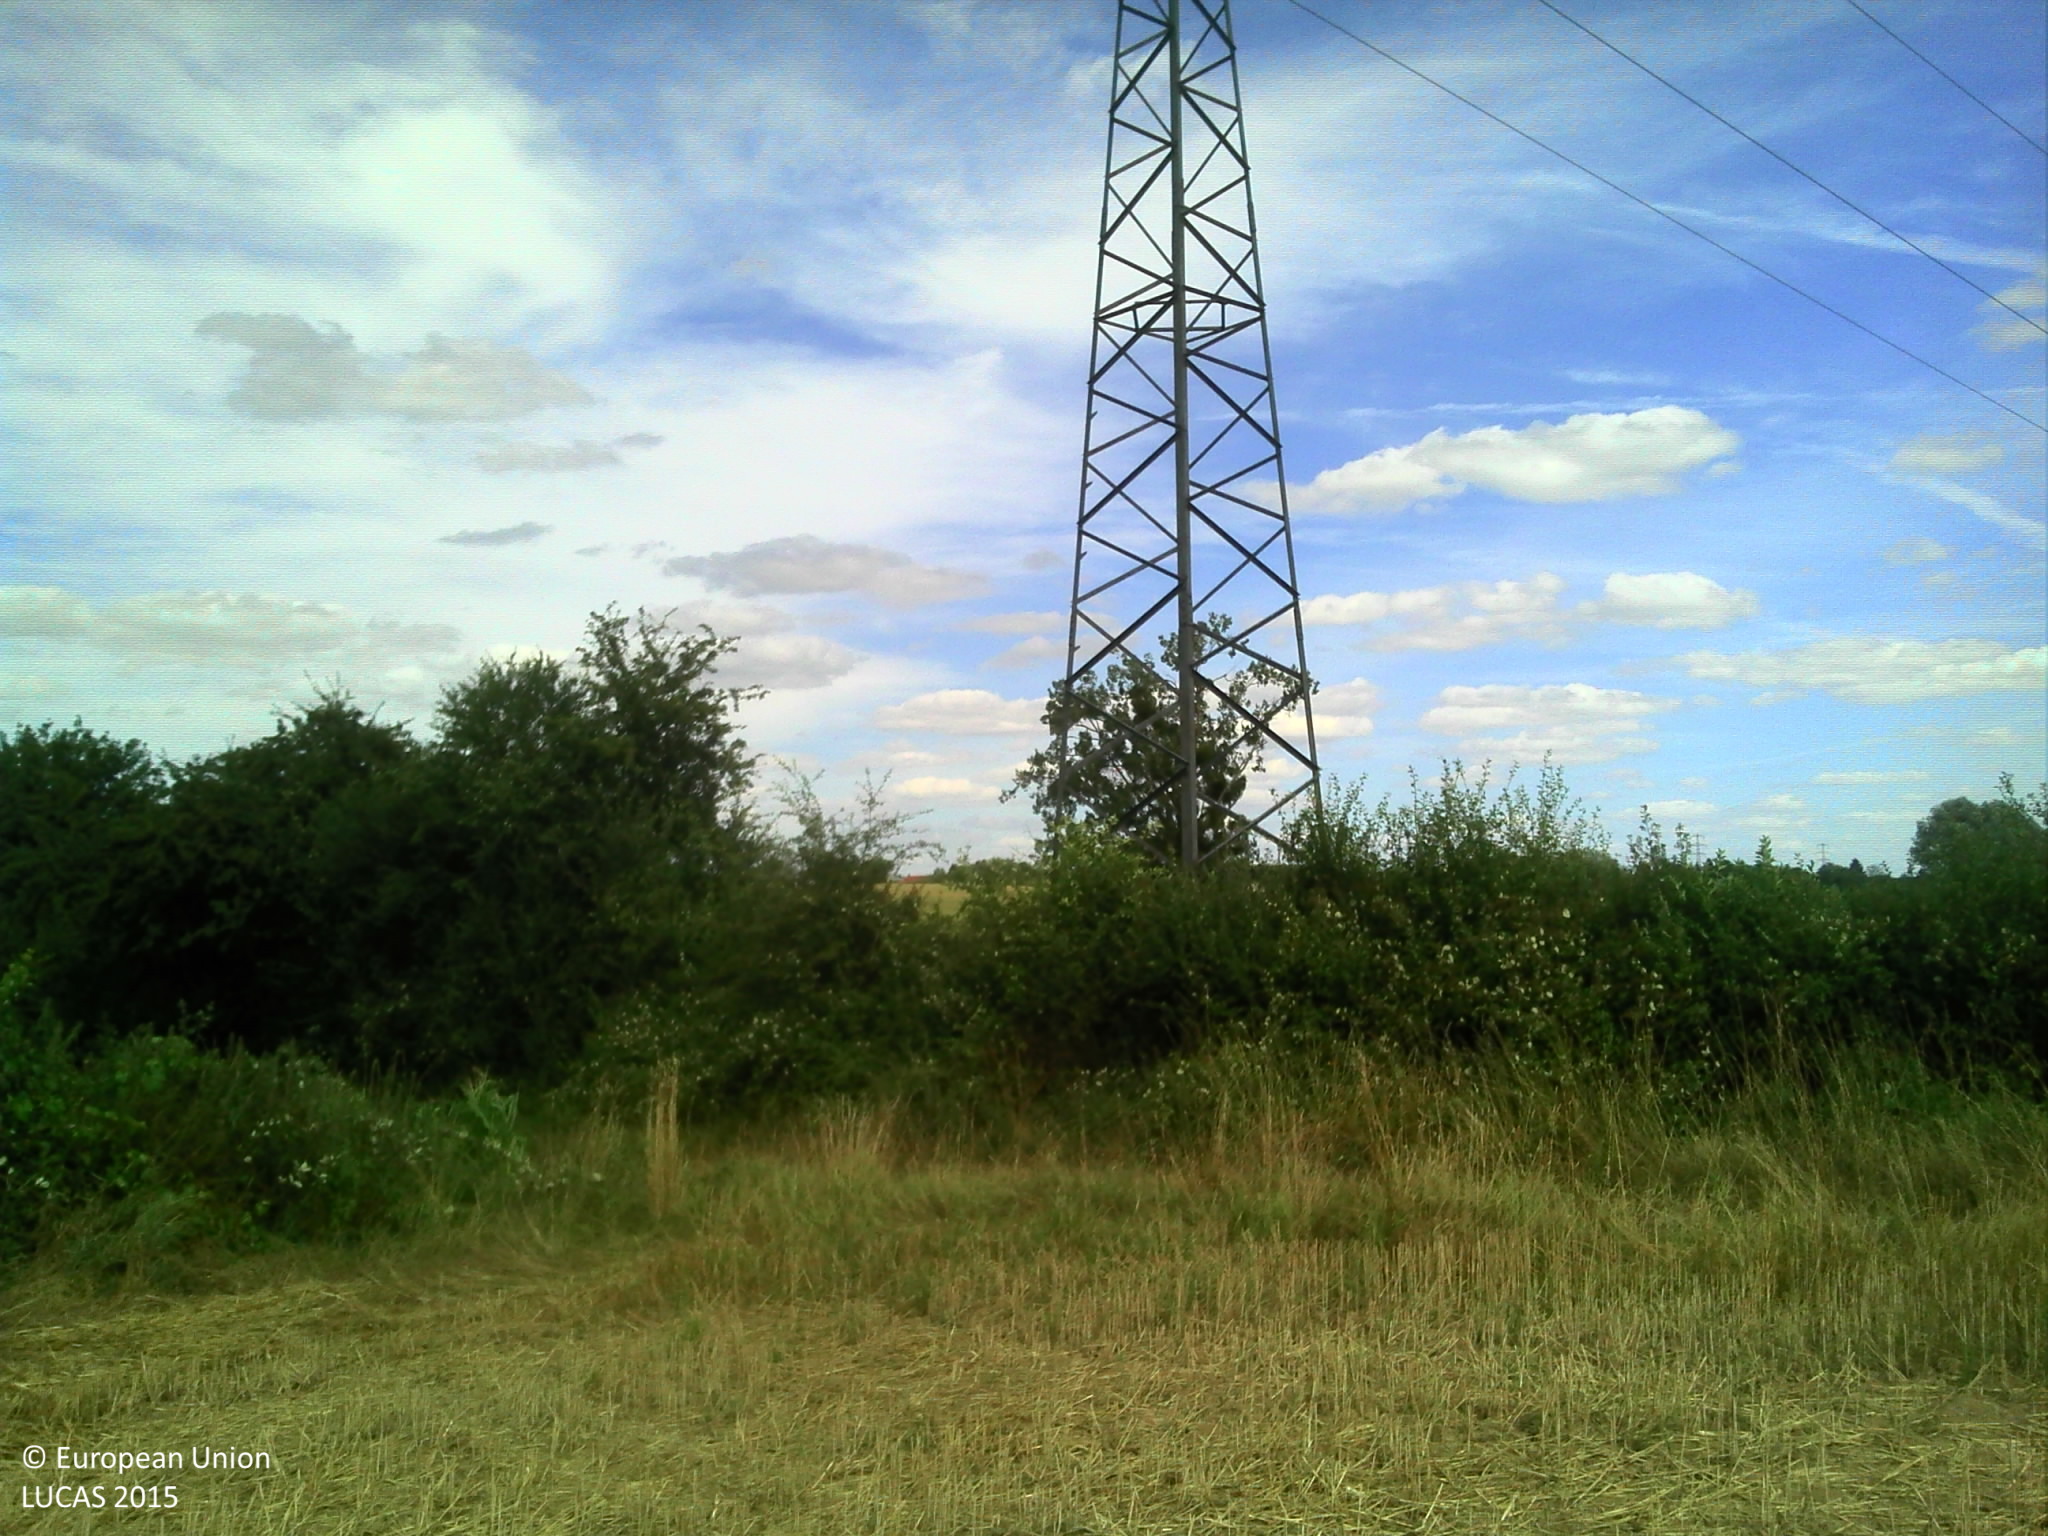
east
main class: Cropland
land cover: Common wheat
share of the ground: > 75 %
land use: Agriculture (excluding fallow land and kitchen gardens)
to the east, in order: Common wheat; Ditches and canals; Abandoned hedges; Electric lines; Grassland without tree/shrub cover; Managed hedges; Single bushes/trees; Grassland without tree/shrub cover; Inland fresh running water; Grassland without tree/shrub cover
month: July
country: FR
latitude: 46.7663
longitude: 4.8028
